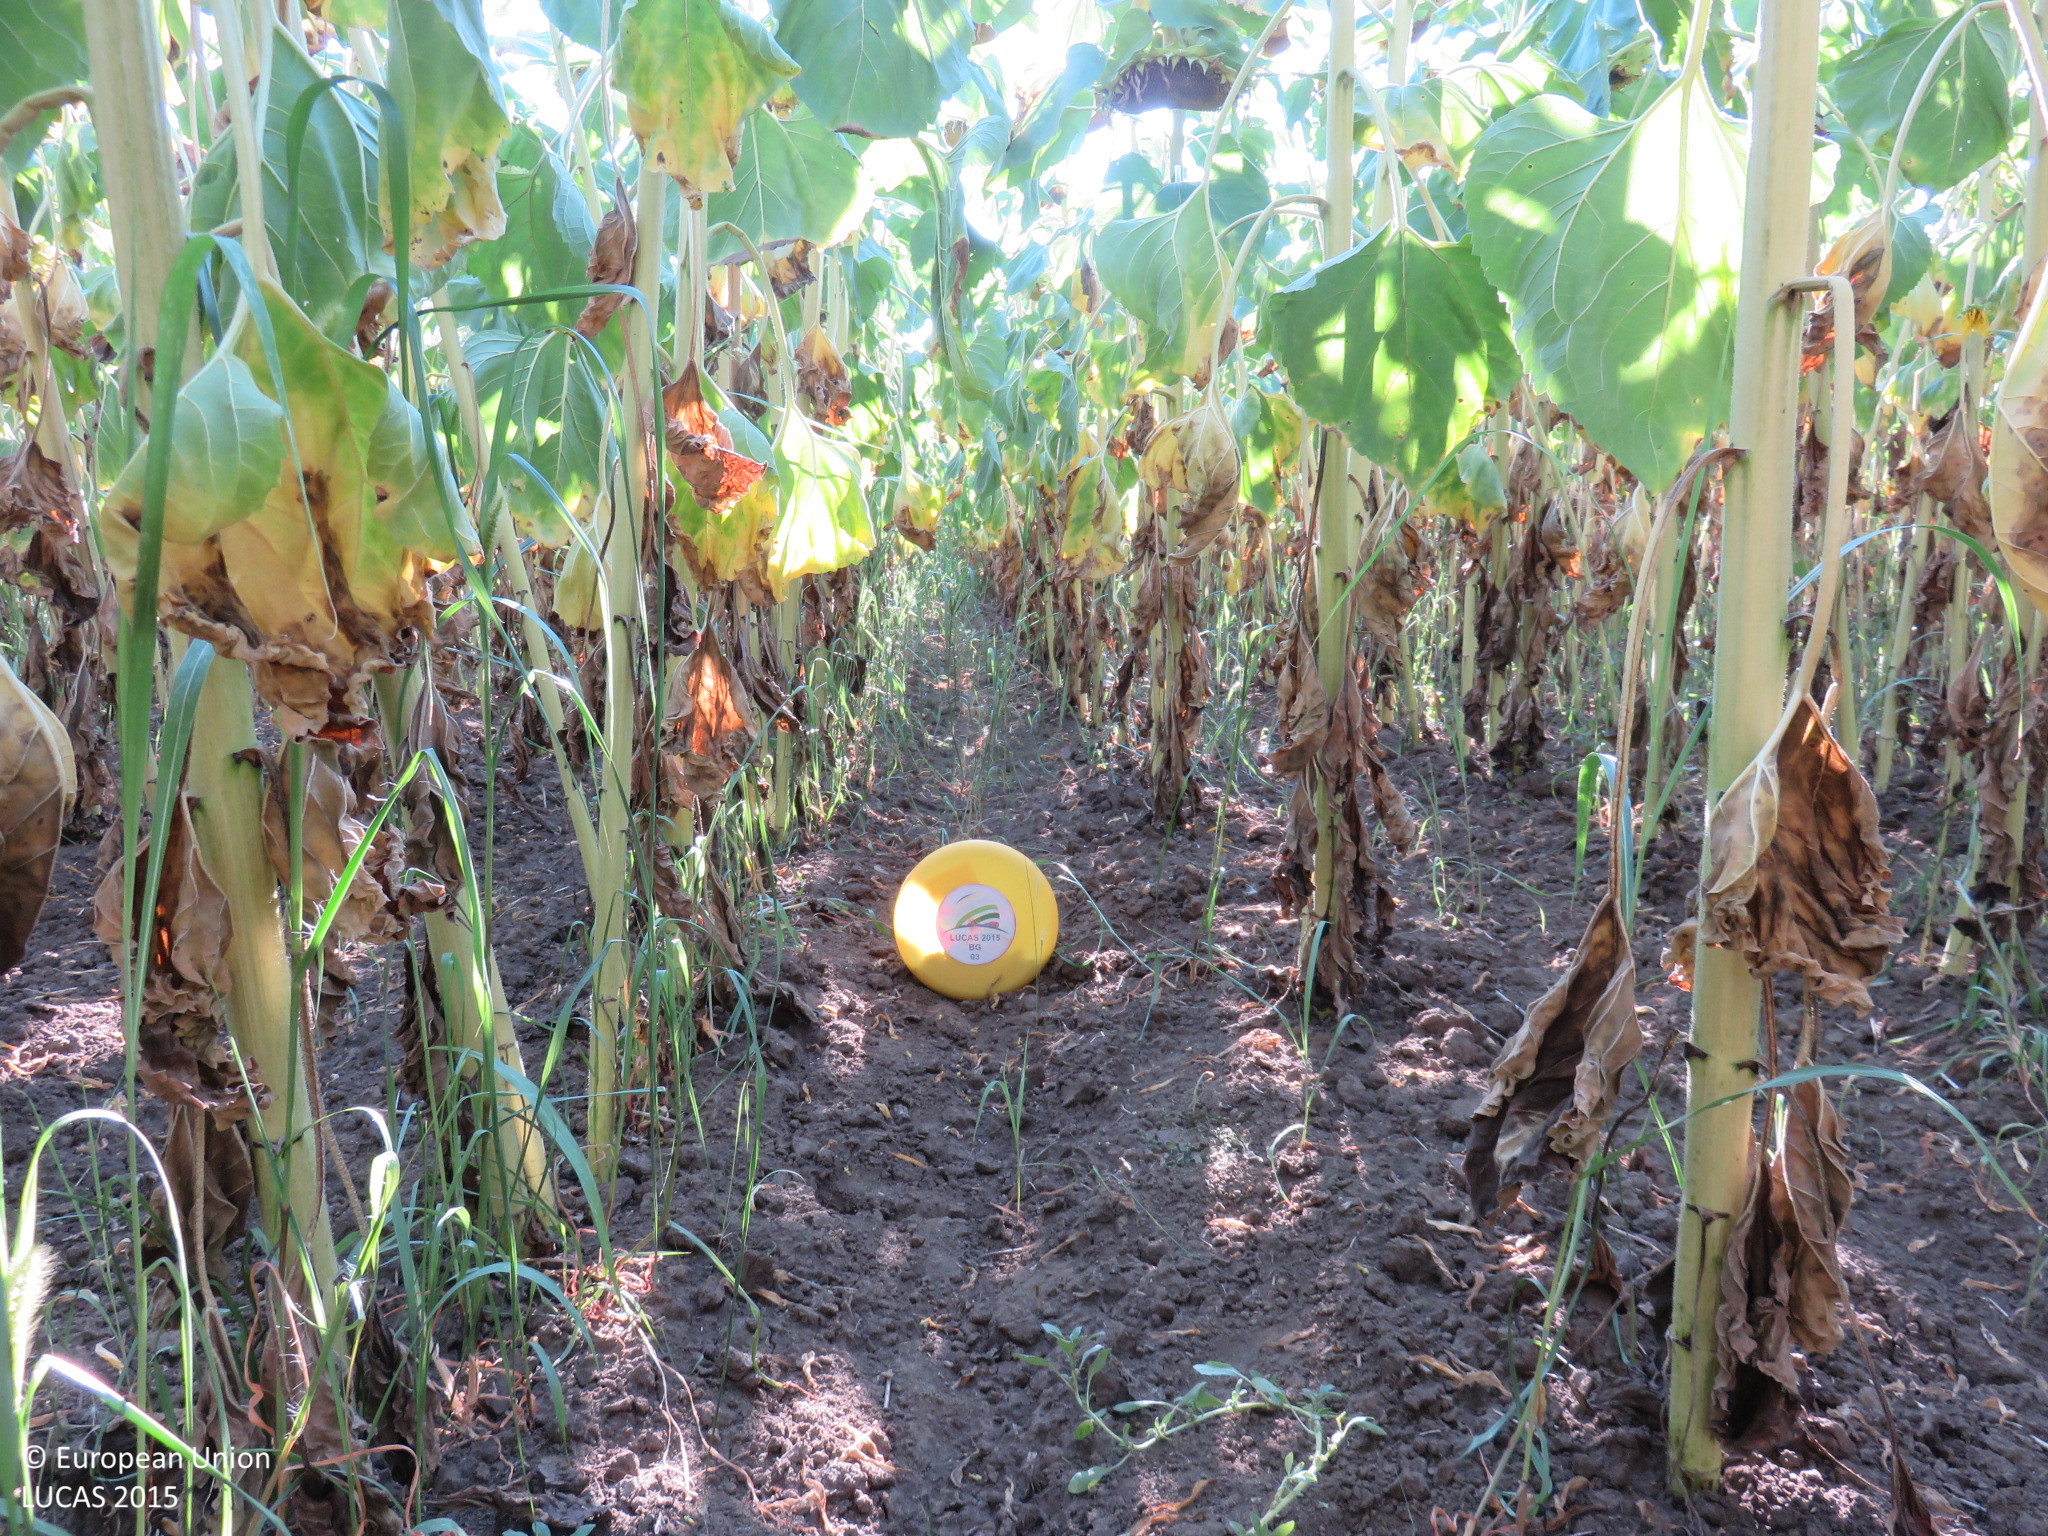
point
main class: Cropland
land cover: Sunflower
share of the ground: > 75 %
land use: Agriculture (excluding fallow land and kitchen gardens)
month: July
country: BG
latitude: 43.3854
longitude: 25.0947
